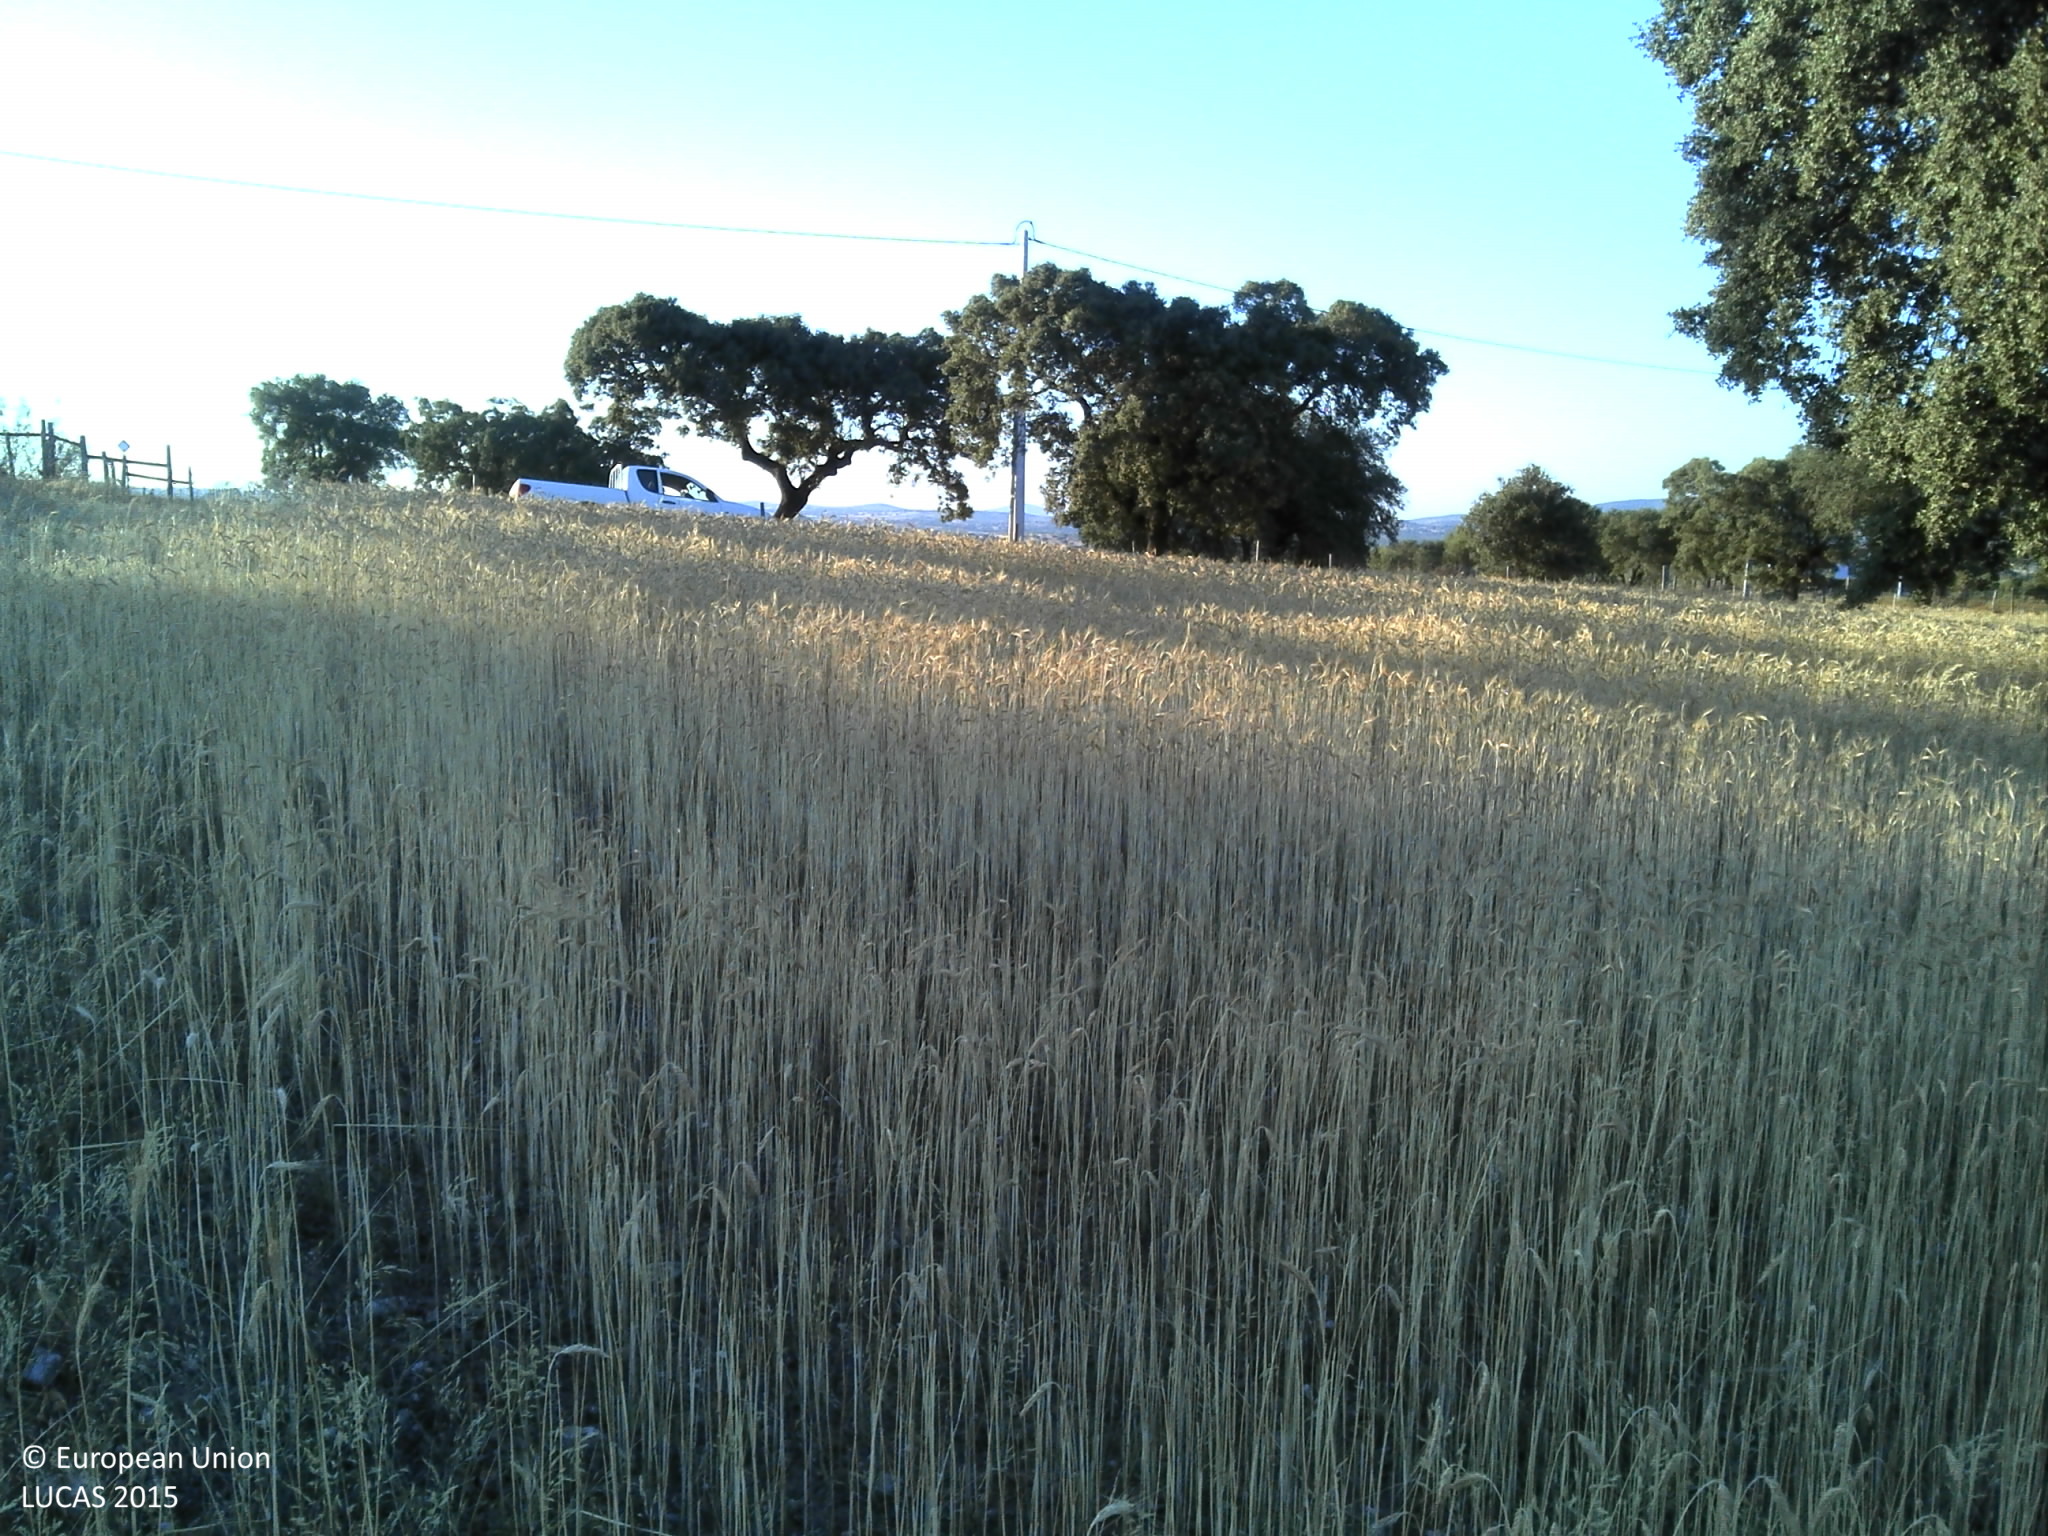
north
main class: Cropland
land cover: Common wheat
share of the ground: > 75 %
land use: Agriculture (excluding fallow land and kitchen gardens)
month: June
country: PT
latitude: 37.8986
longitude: -7.3335
